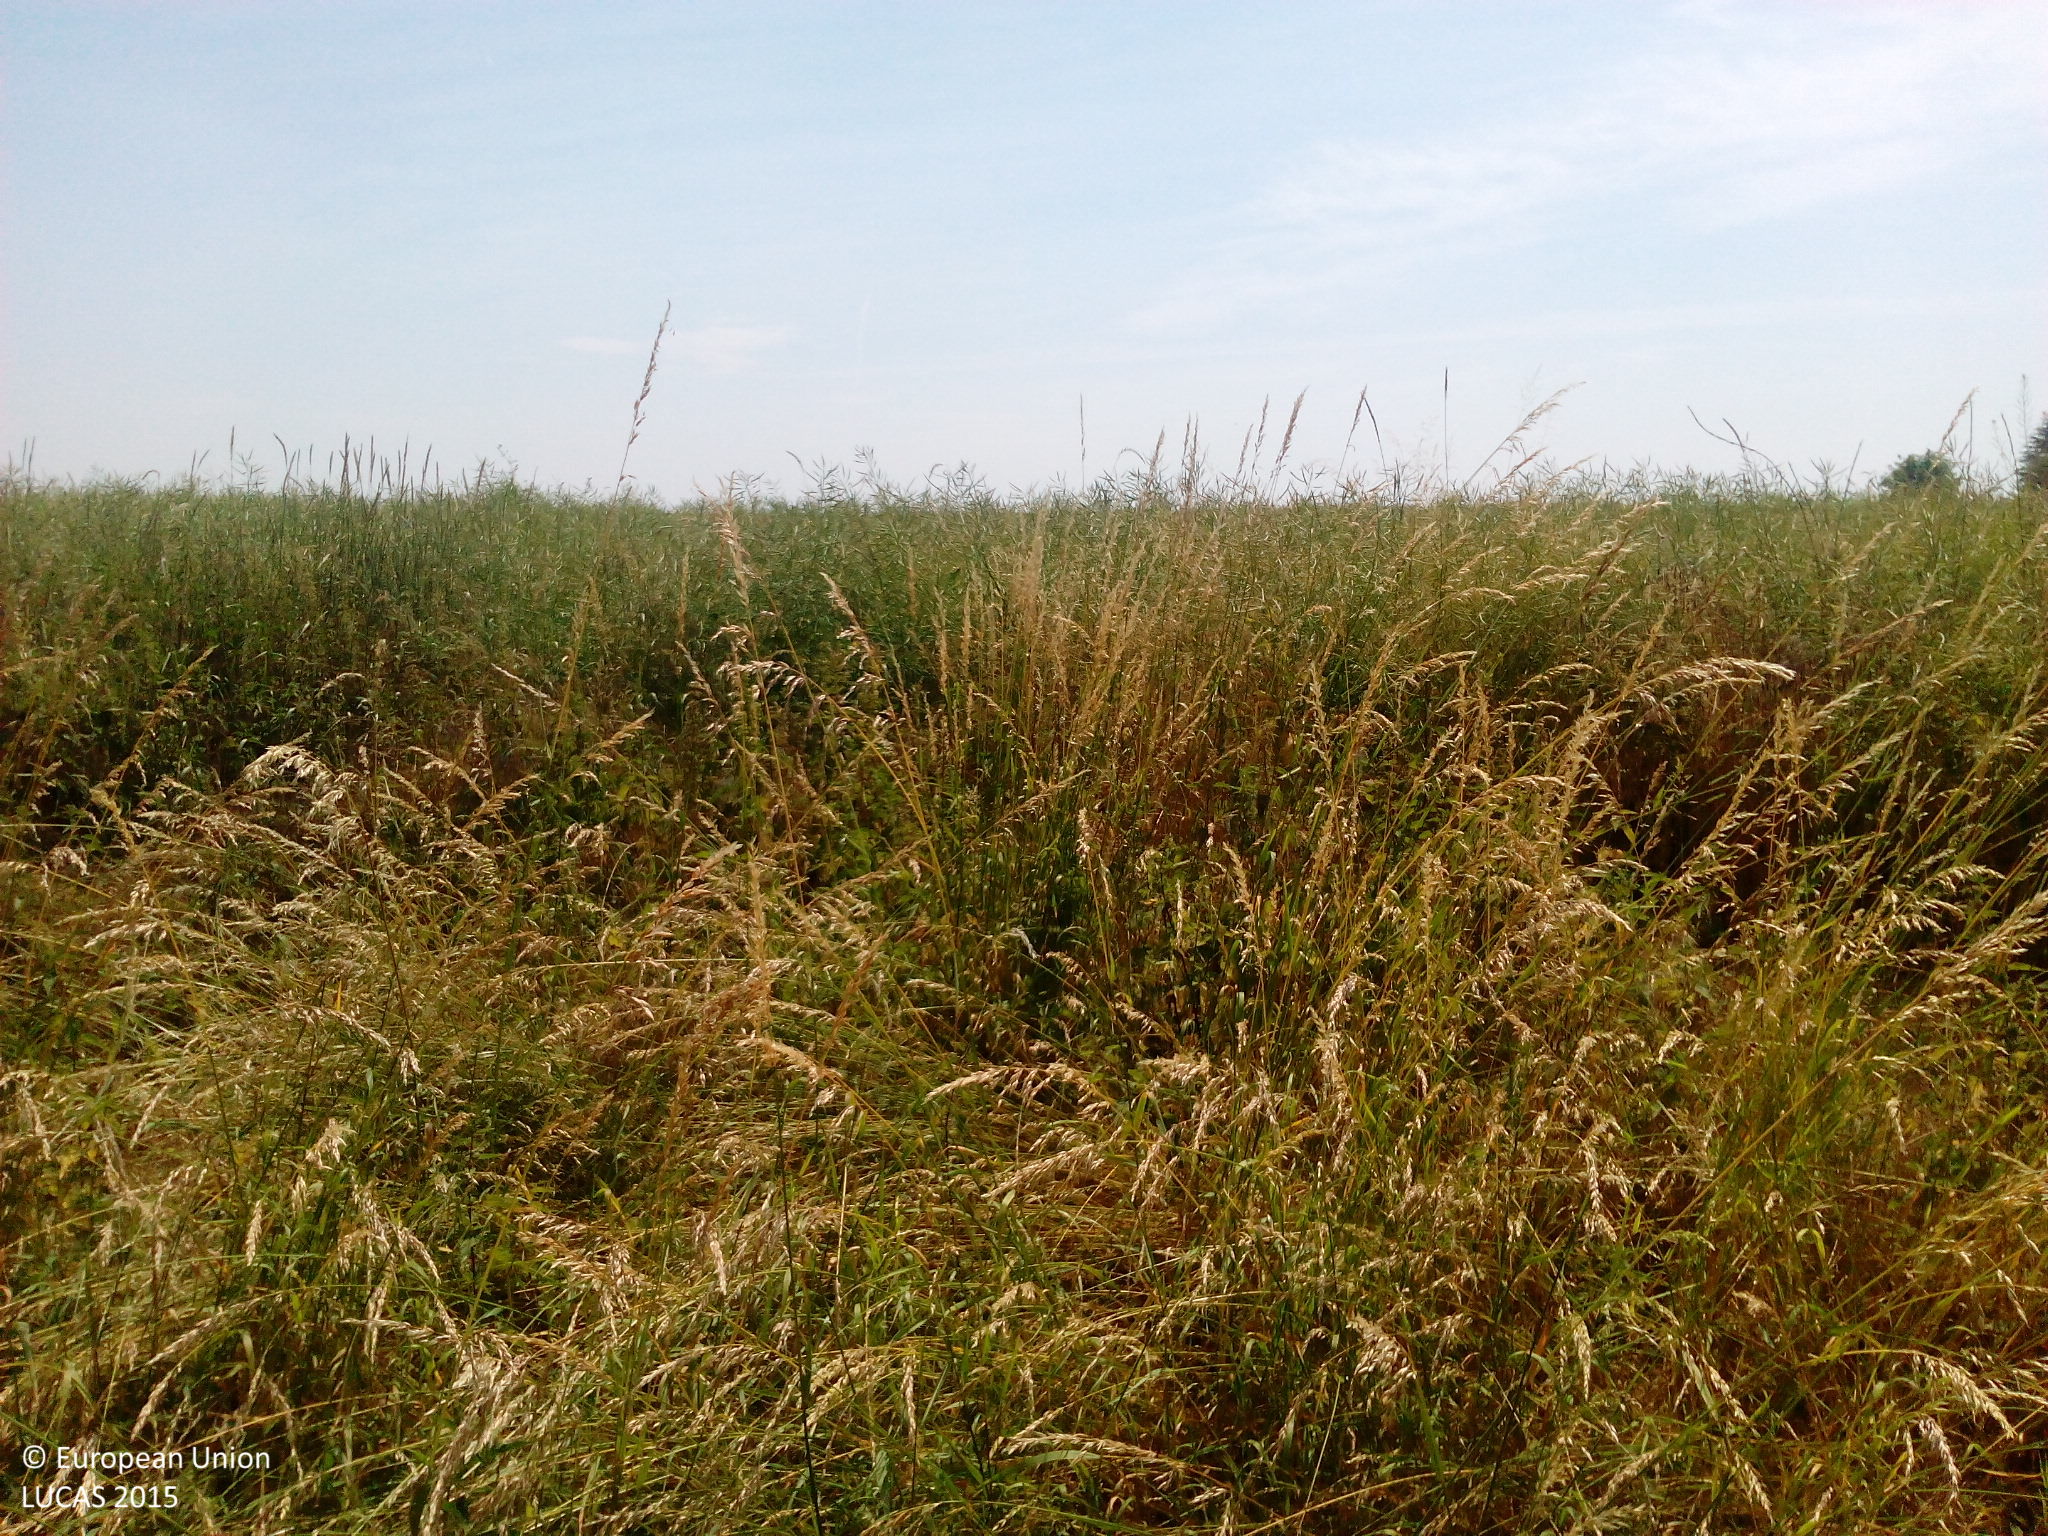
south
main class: Cropland
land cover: Rape and turnip rape
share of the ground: > 75 %
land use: Agriculture (excluding fallow land and kitchen gardens)
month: July
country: DE
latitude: 51.4865
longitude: 11.5406
